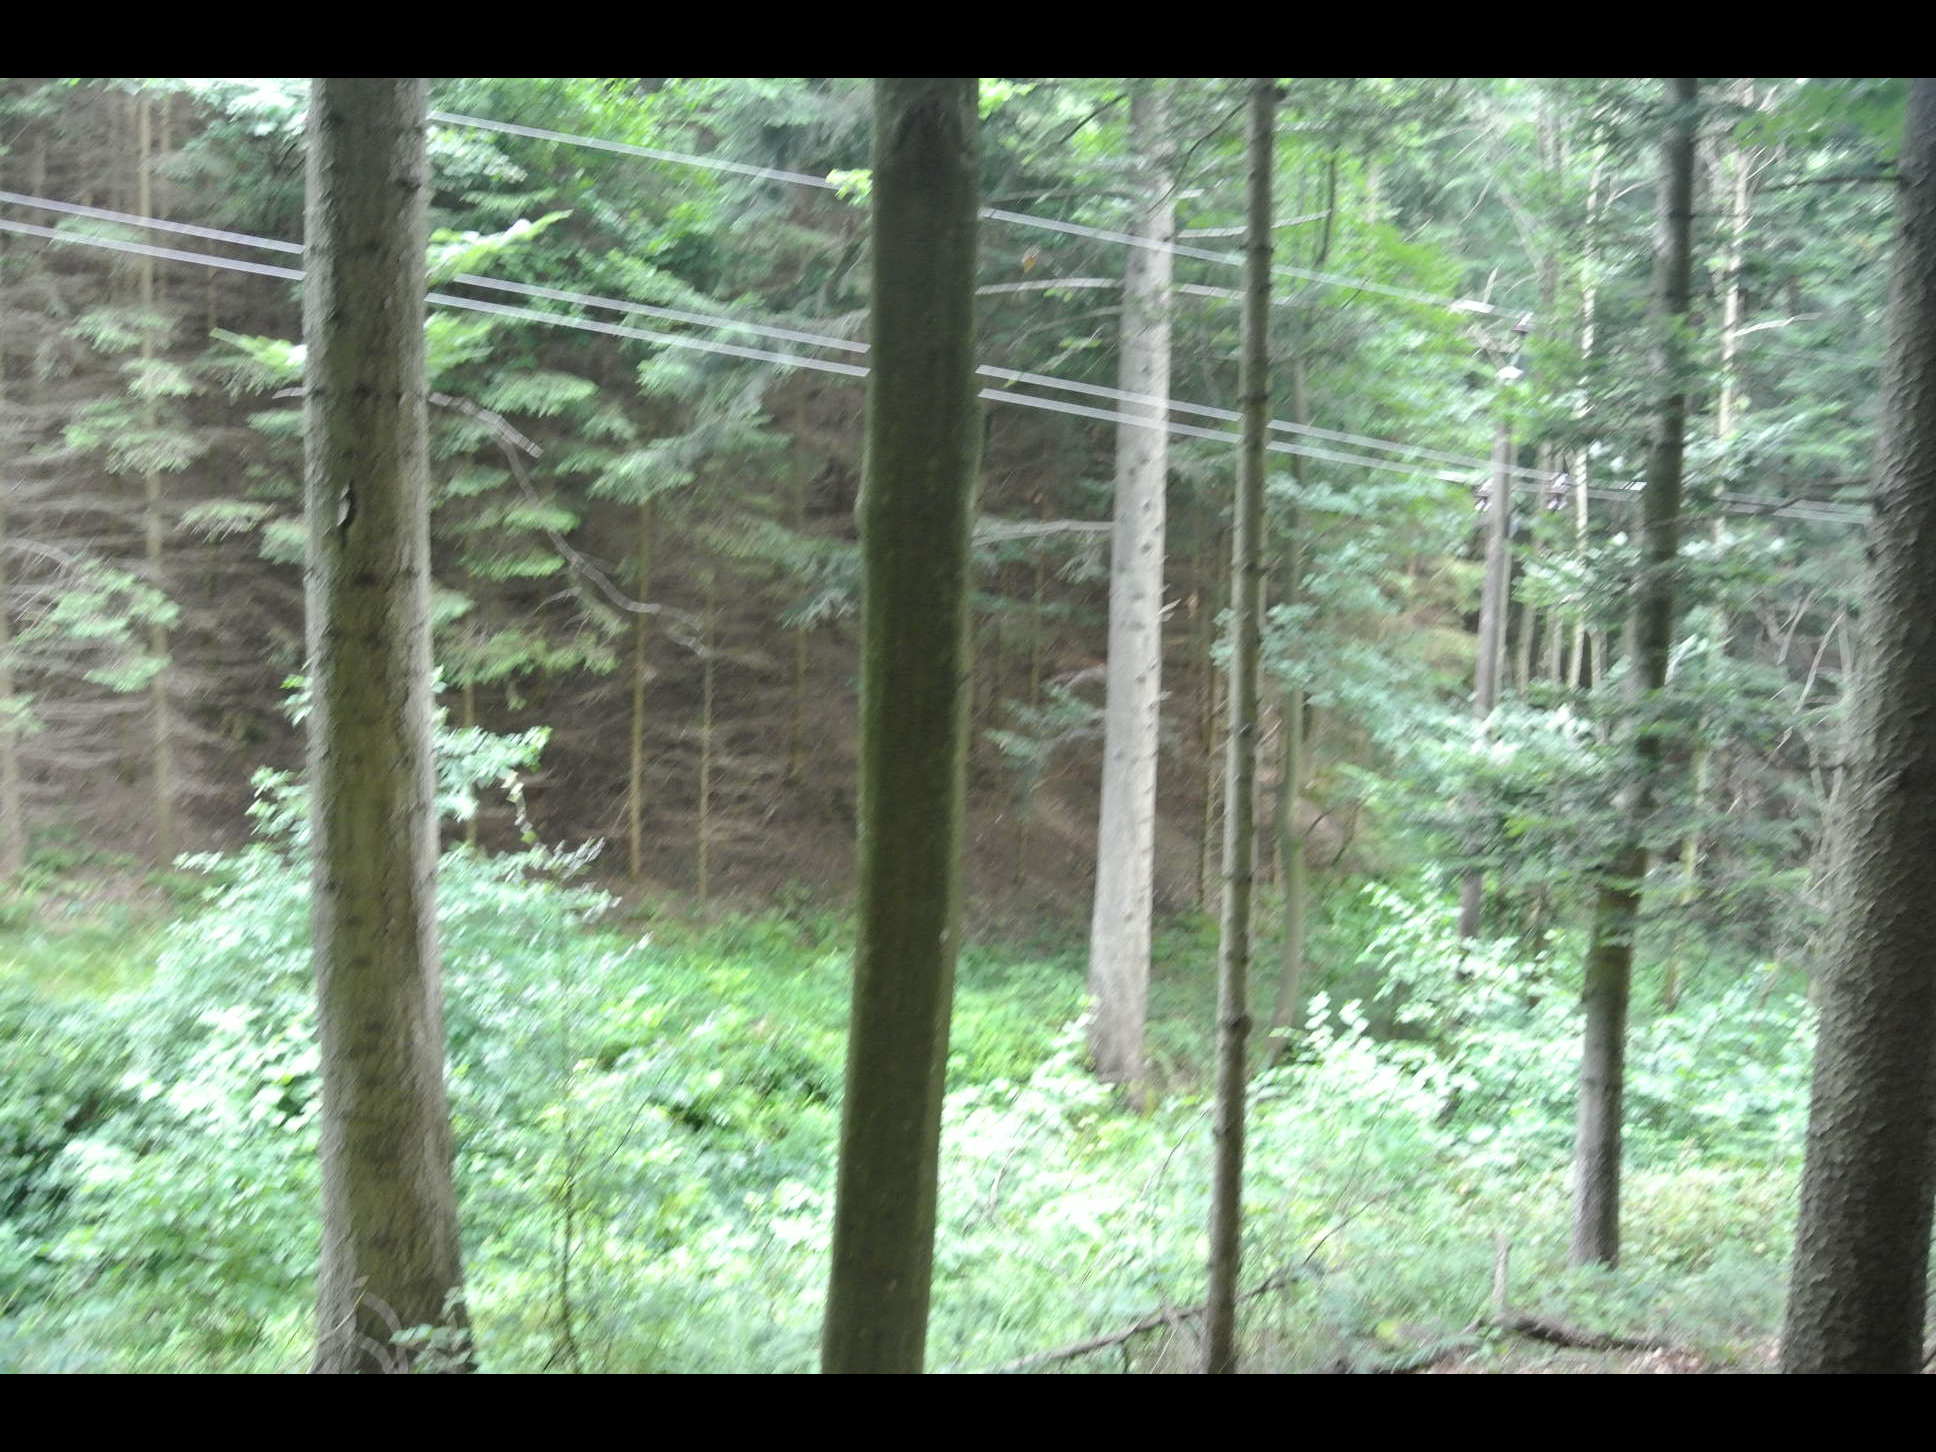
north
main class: Woodland
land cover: Spruce dominated coniferous woodland
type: alpine coniferous forest
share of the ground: > 75 %
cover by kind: coniferous forest trees 75 %, broadleaved forest trees 20 %, herbaceous plants 5 %
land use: Forestry
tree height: > 5 m
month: July
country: AT
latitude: 47.6209
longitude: 16.1101
